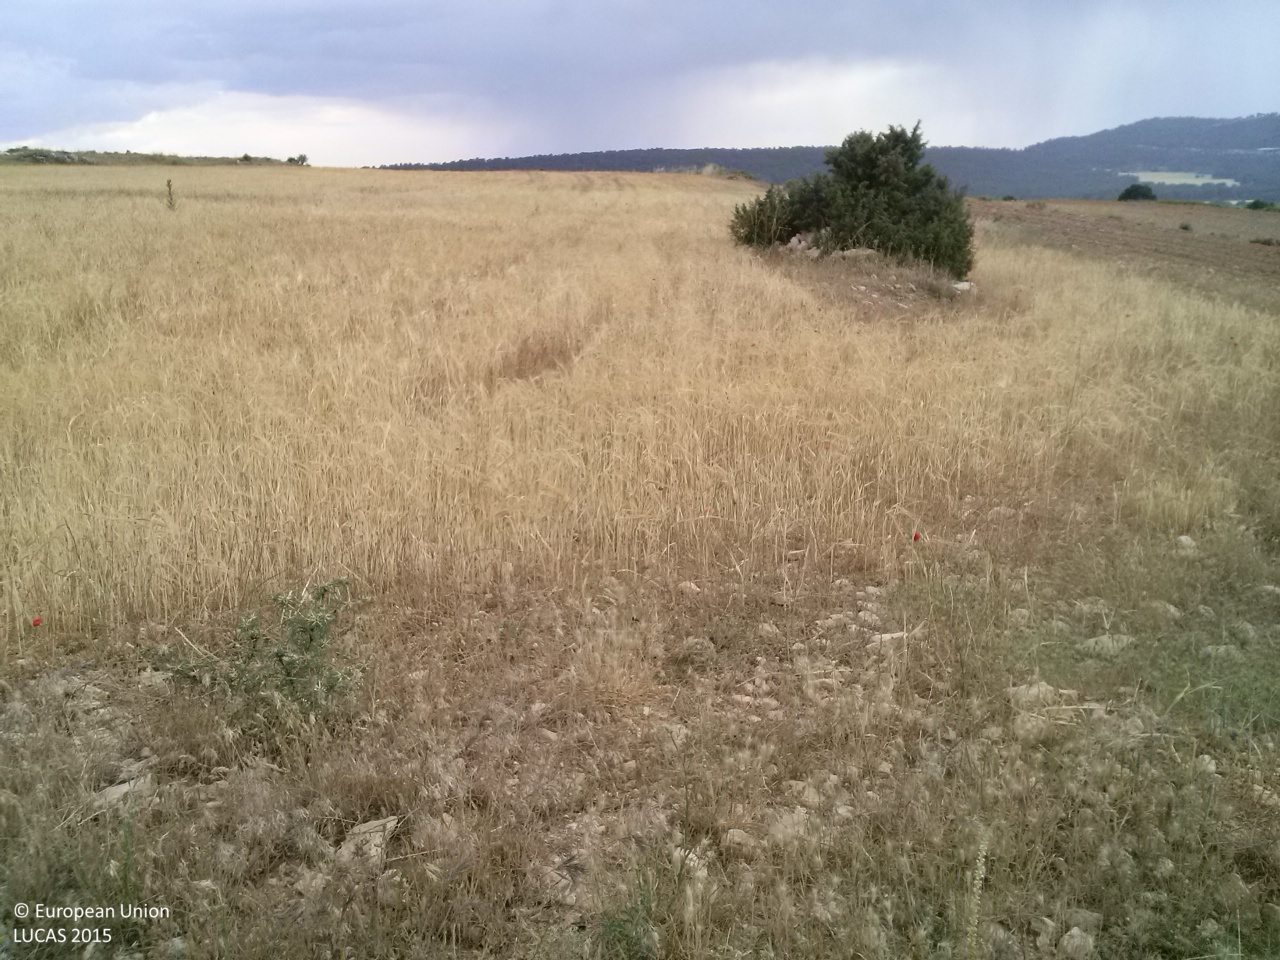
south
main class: Grassland
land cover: Grassland without tree/shrub cover
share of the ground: > 75 %
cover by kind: herbaceous plants 80 %, consolidated bare surface 20 %
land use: Agriculture (excluding fallow land and kitchen gardens)
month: June
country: ES
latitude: 39.8954
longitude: -1.8352
